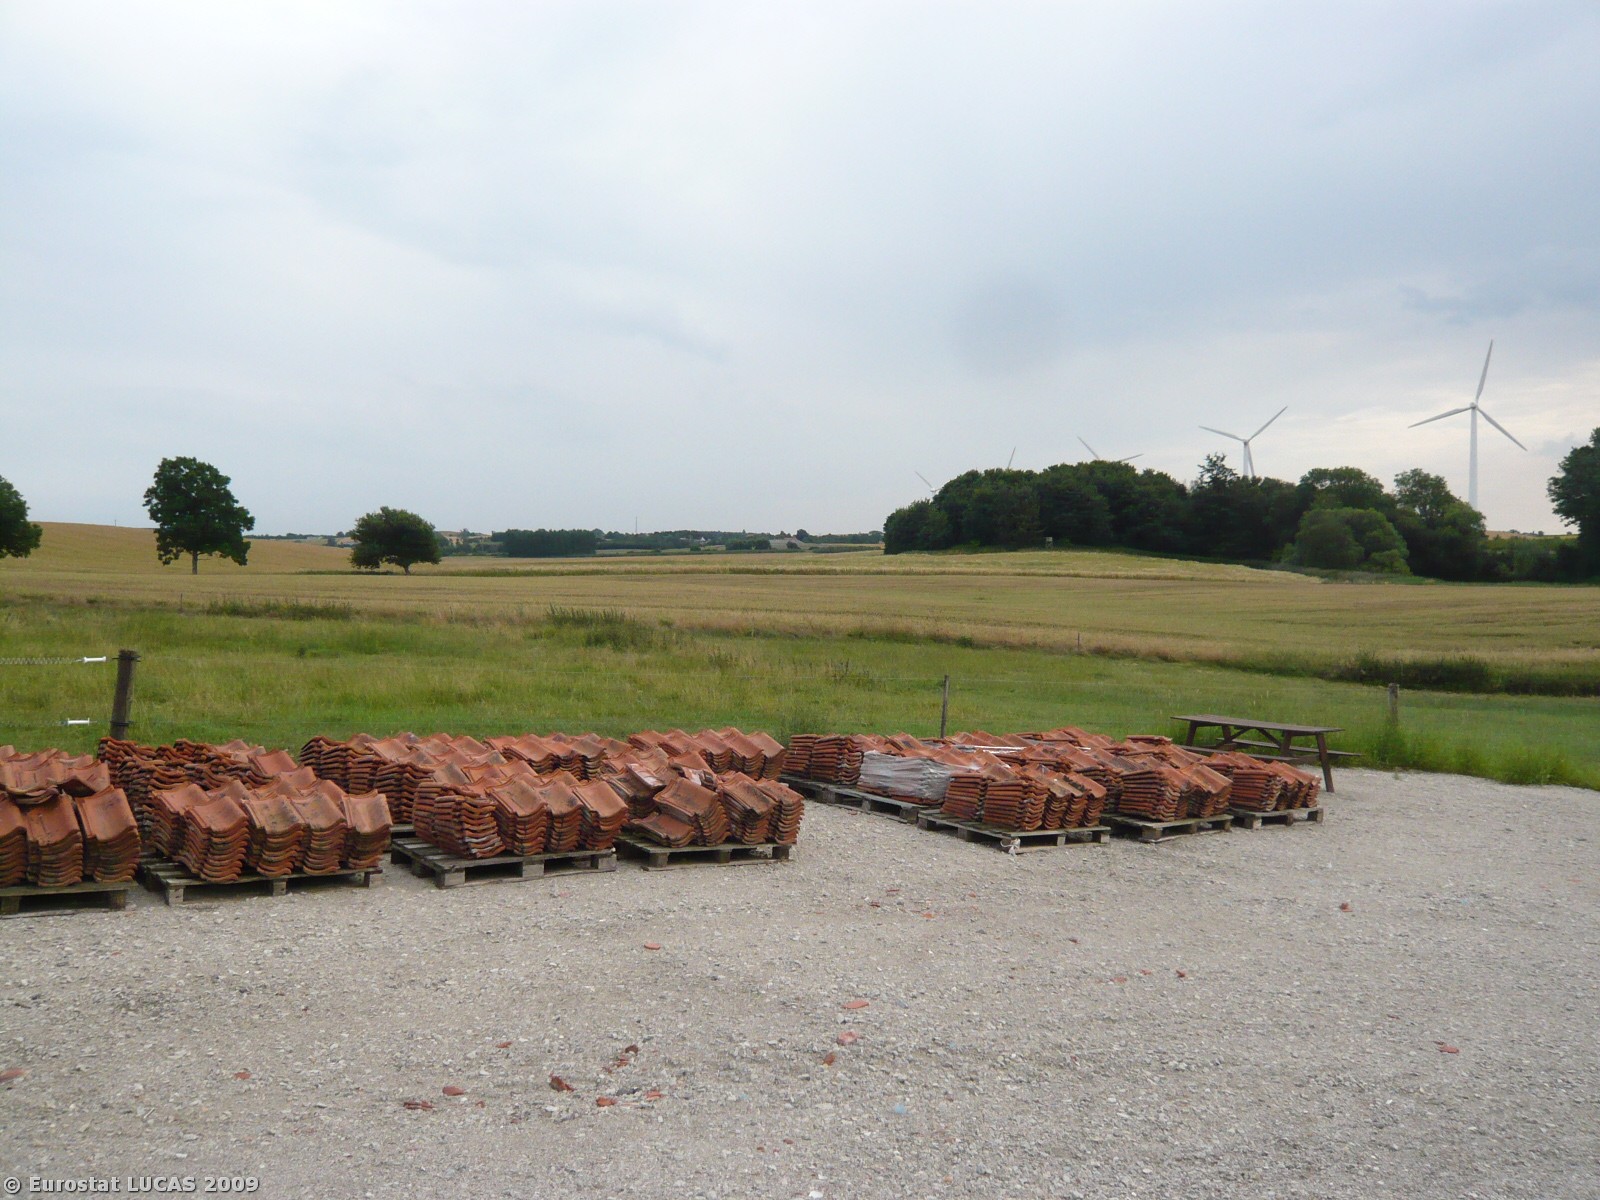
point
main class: Cropland
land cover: Rape and turnip rape
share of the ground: > 75 %
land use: Agriculture (excluding fallow land and kitchen gardens)
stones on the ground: < 10 %
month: July
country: DK
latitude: 55.7308
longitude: 11.3841
